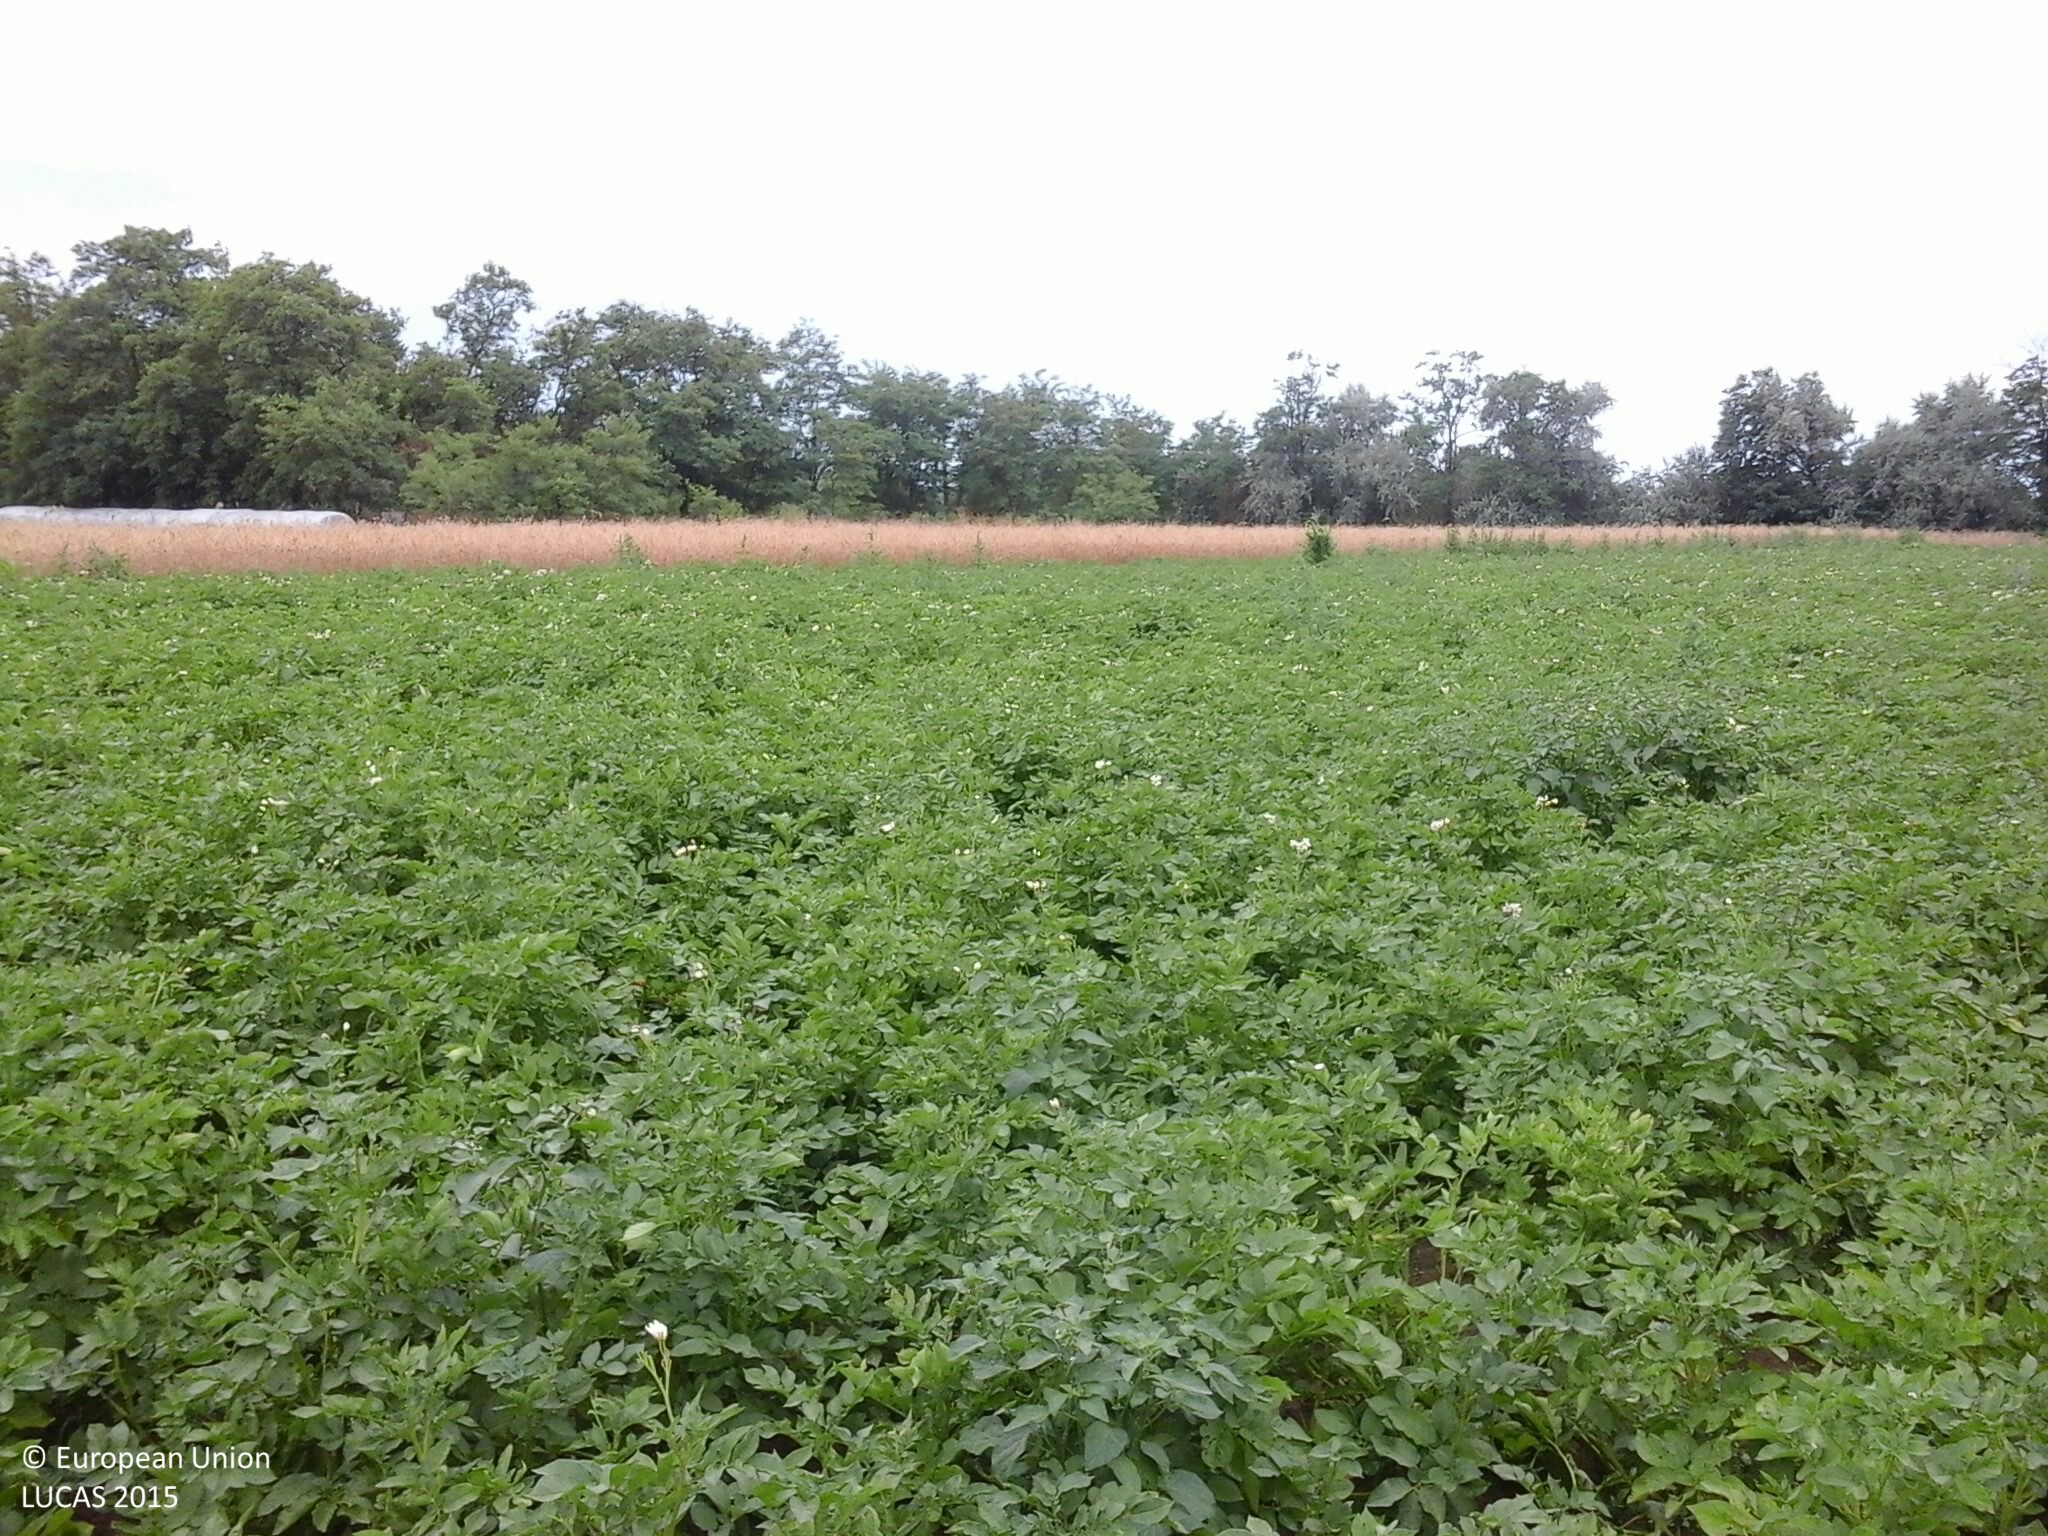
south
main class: Cropland
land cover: Potatoes
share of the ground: > 75 %
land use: Agriculture (excluding fallow land and kitchen gardens)
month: July
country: HU
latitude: 46.4766
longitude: 20.0379
